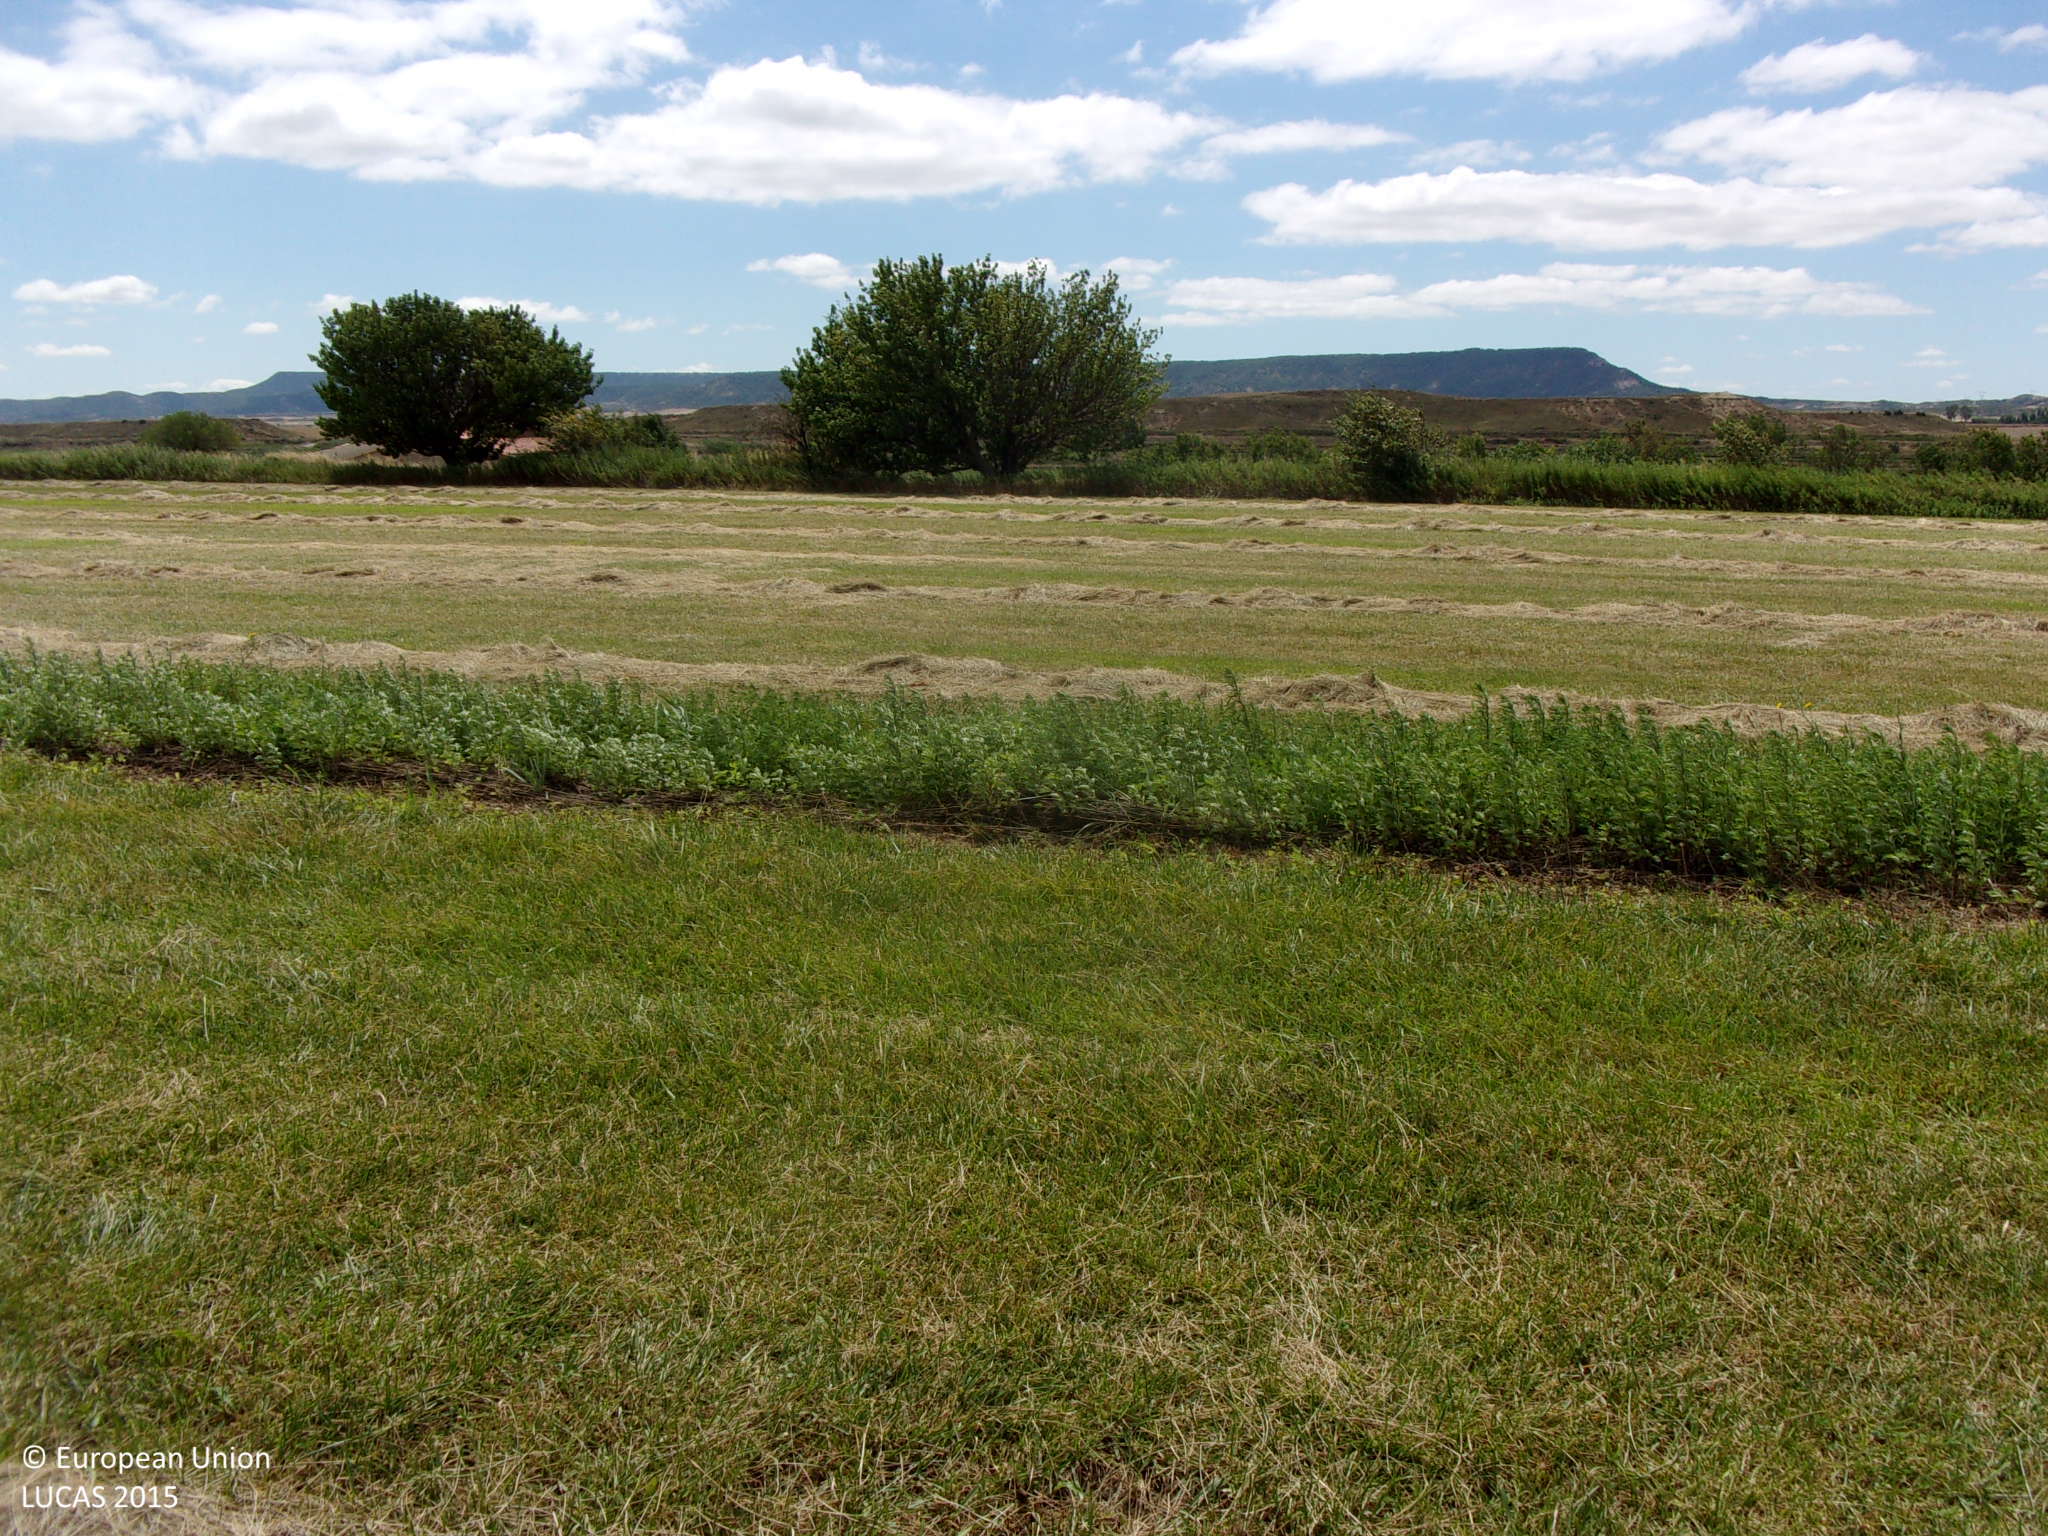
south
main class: Cropland
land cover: Mixed cereals for fodder
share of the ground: > 75 %
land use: Agriculture (excluding fallow land and kitchen gardens)
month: August
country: ES
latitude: 42.1600
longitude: -1.3468
